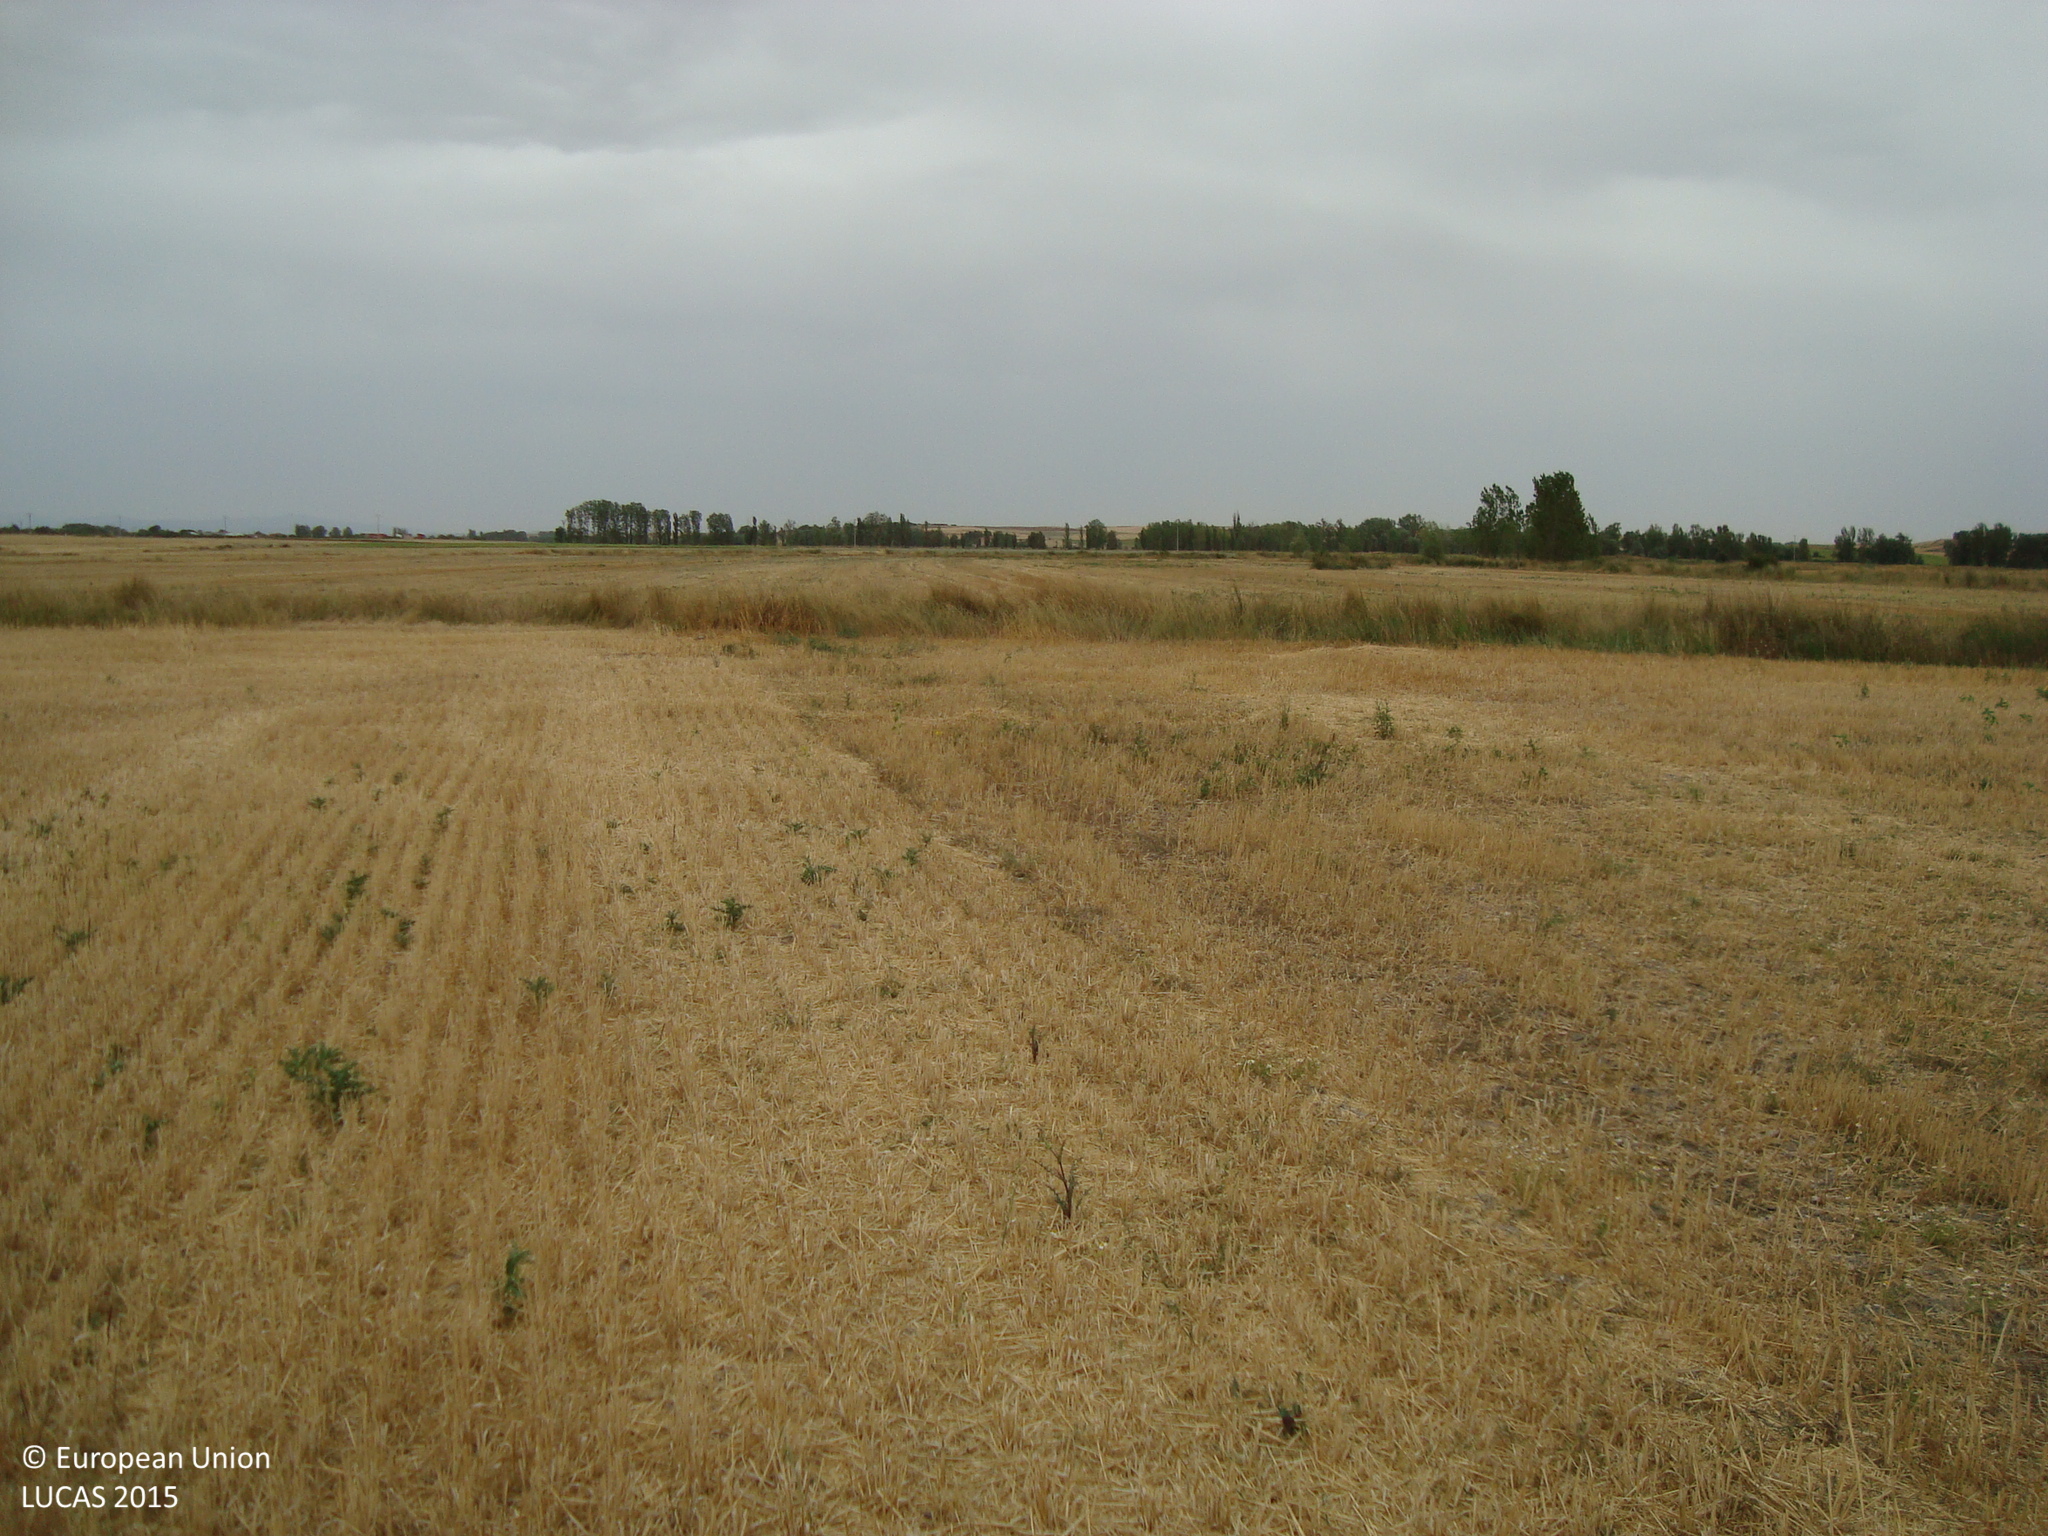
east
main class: Cropland
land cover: Barley
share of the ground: > 75 %
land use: Agriculture (excluding fallow land and kitchen gardens)
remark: Harvested field
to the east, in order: Barley; Rivers and streams; Barley; Rivers and streams; Barley
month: August
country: ES
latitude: 42.1809
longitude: -3.9249
